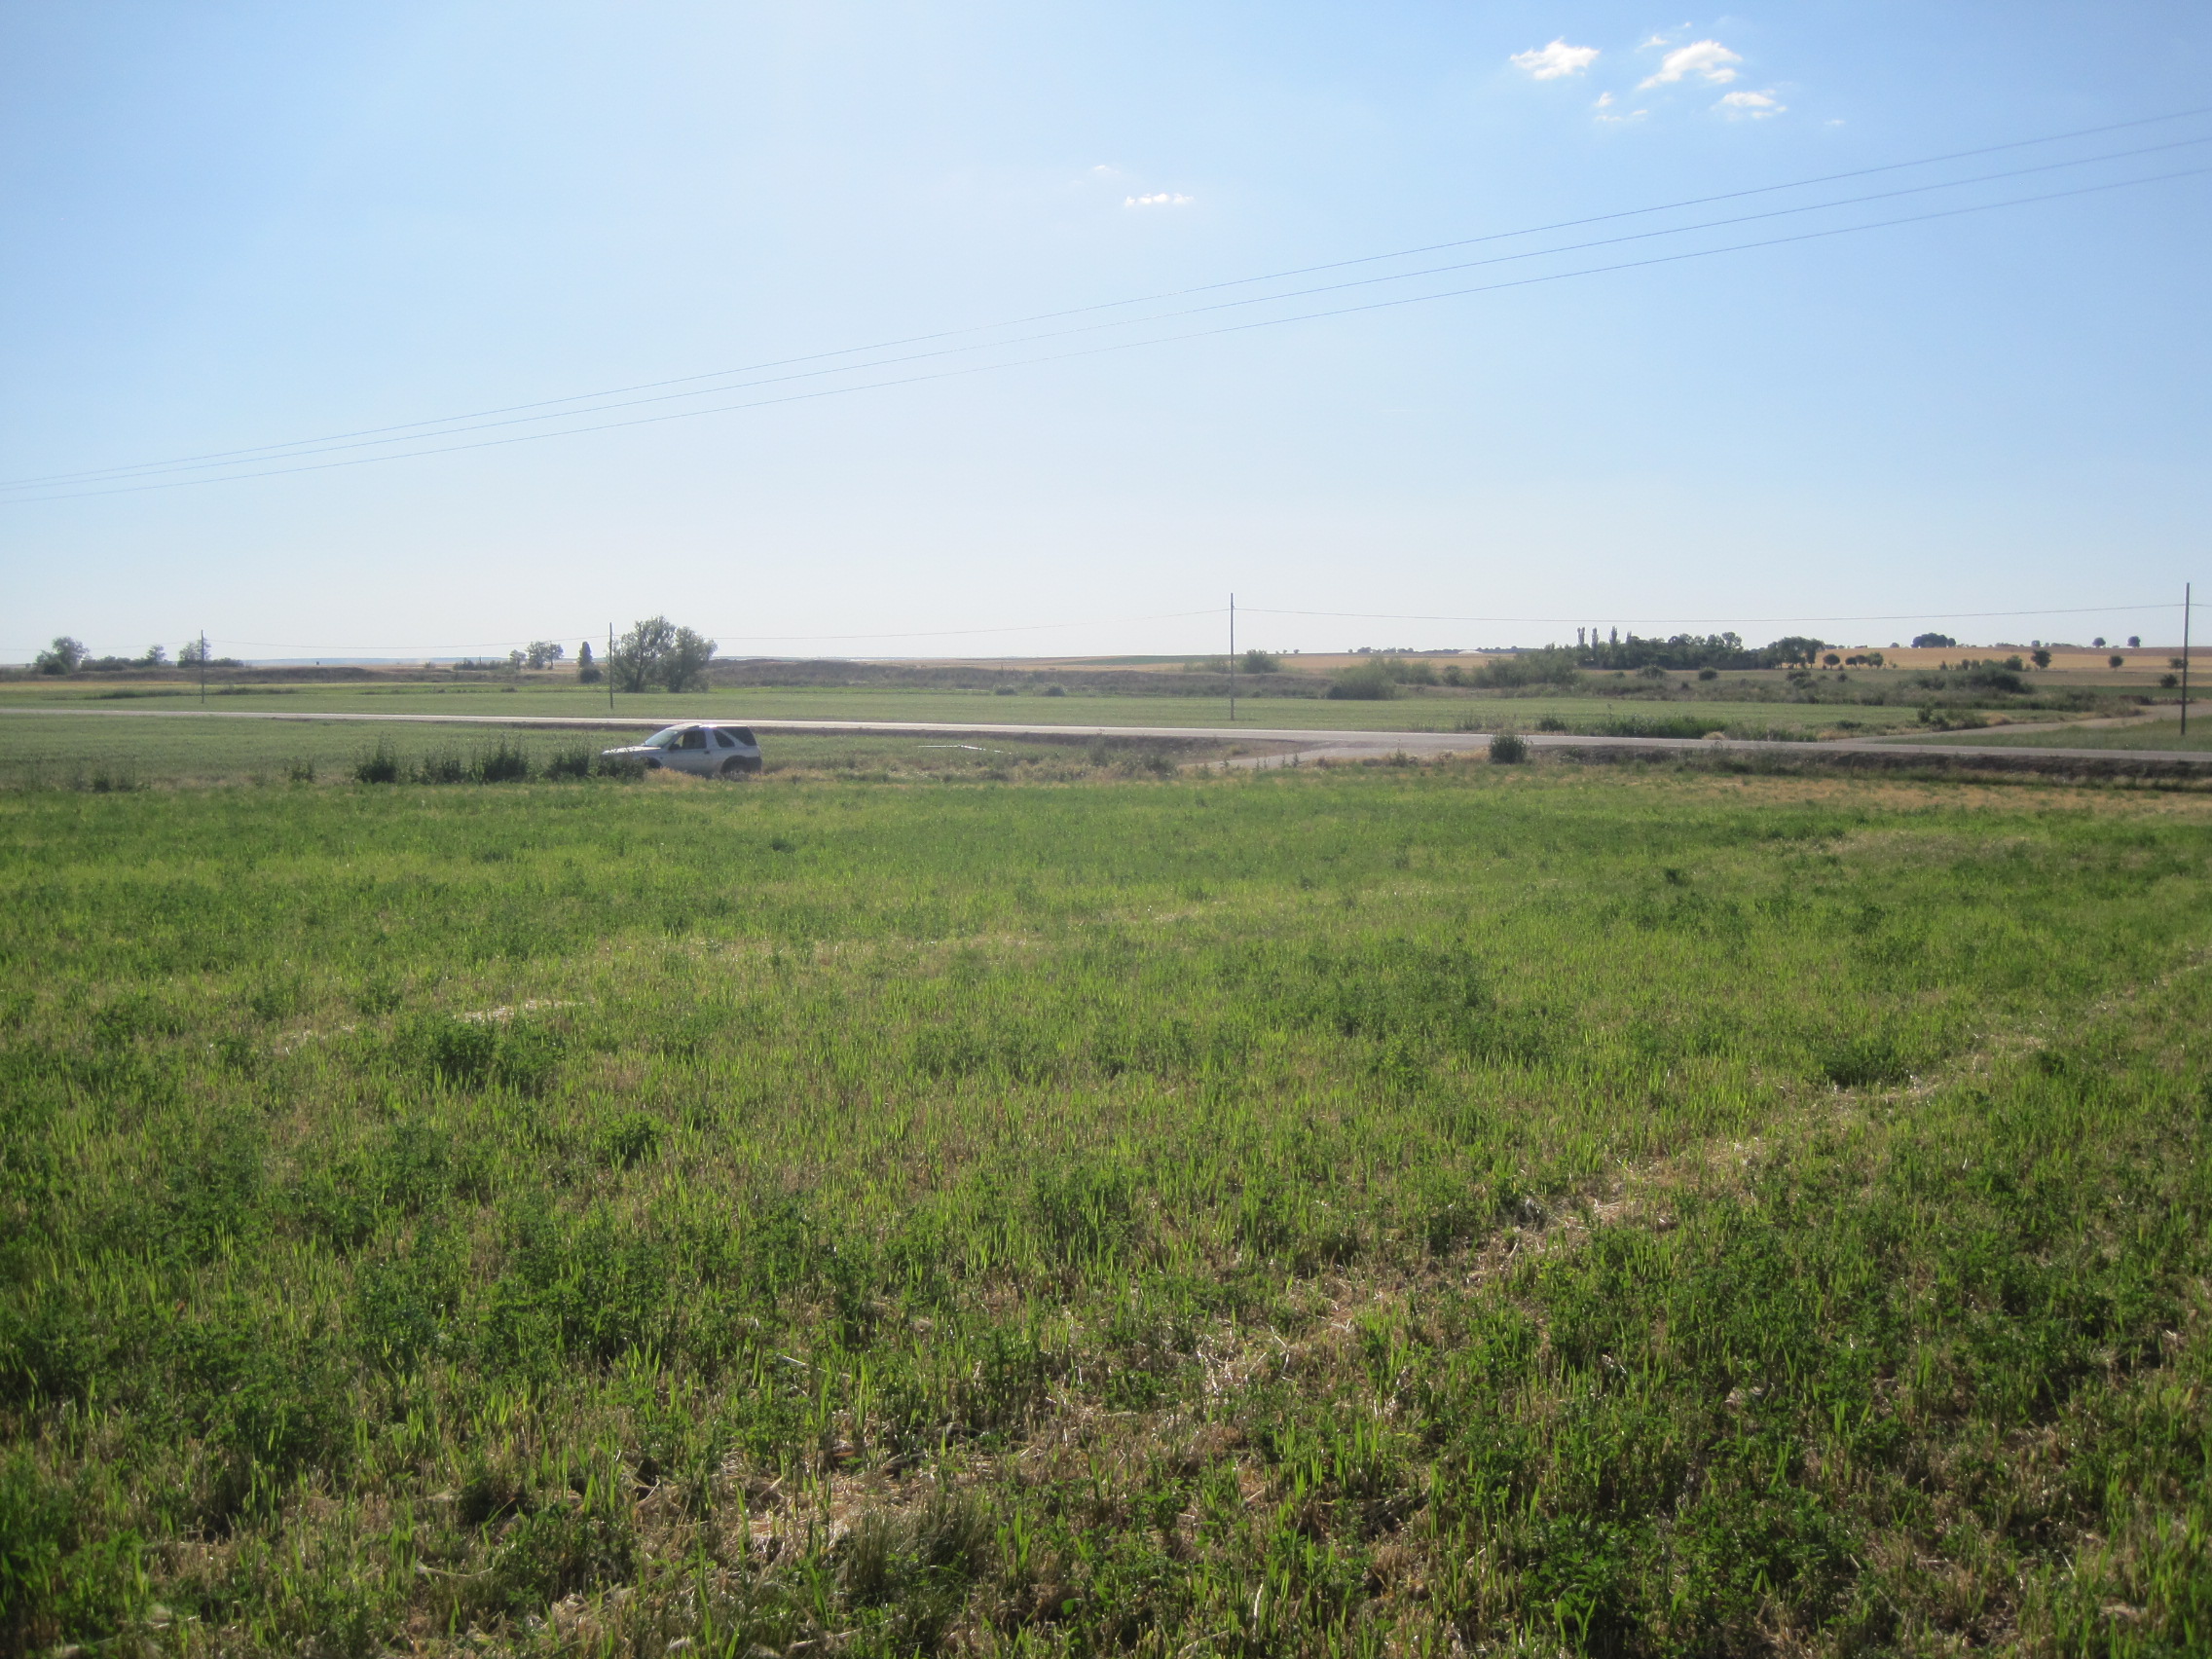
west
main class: Cropland
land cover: Mixed cereals for fodder
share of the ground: > 75 %
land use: Agriculture (excluding fallow land and kitchen gardens)
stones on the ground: 10 - 25 %
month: June
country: ES
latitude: 41.7990
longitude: -5.1587
